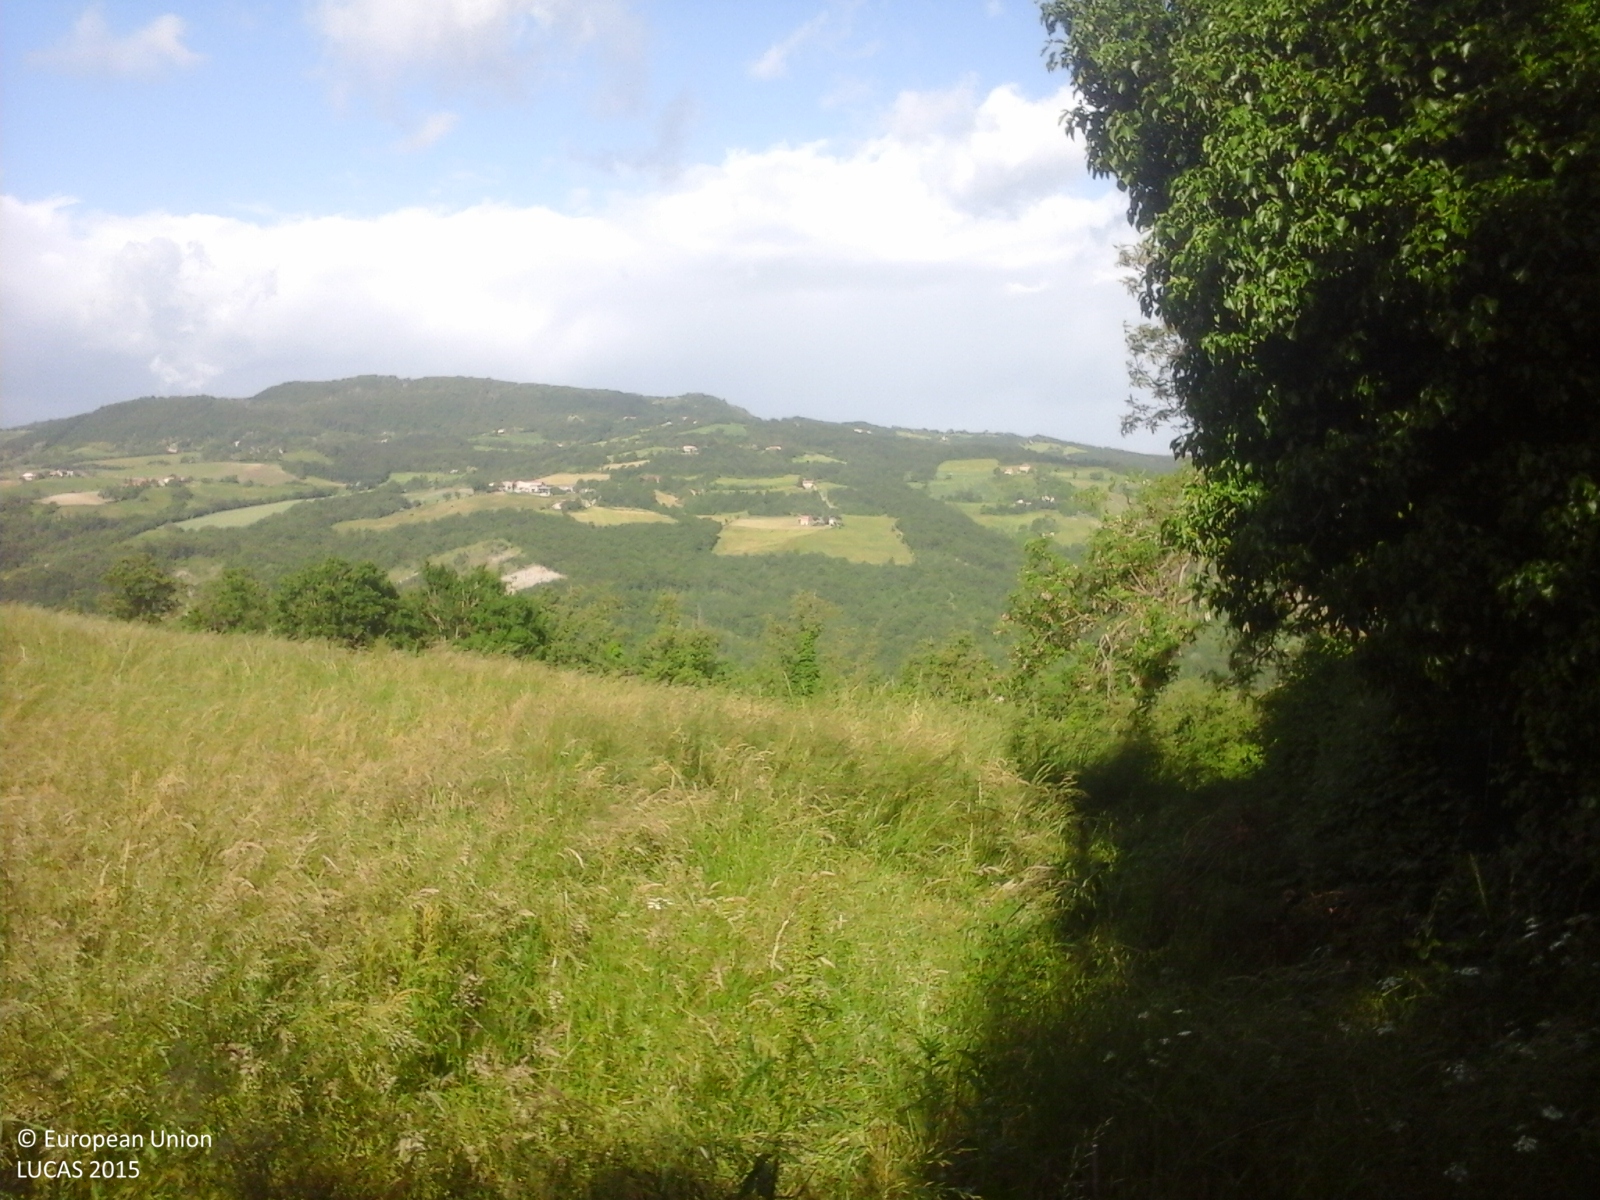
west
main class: Woodland
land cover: Broadleaved woodland
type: thermophilous deciduous forest
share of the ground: > 75 %
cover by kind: broadleaved forest trees 90 %, shrubs 10 %
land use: Forestry
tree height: > 5 m
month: May
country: IT
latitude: 44.3451
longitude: 11.0638
